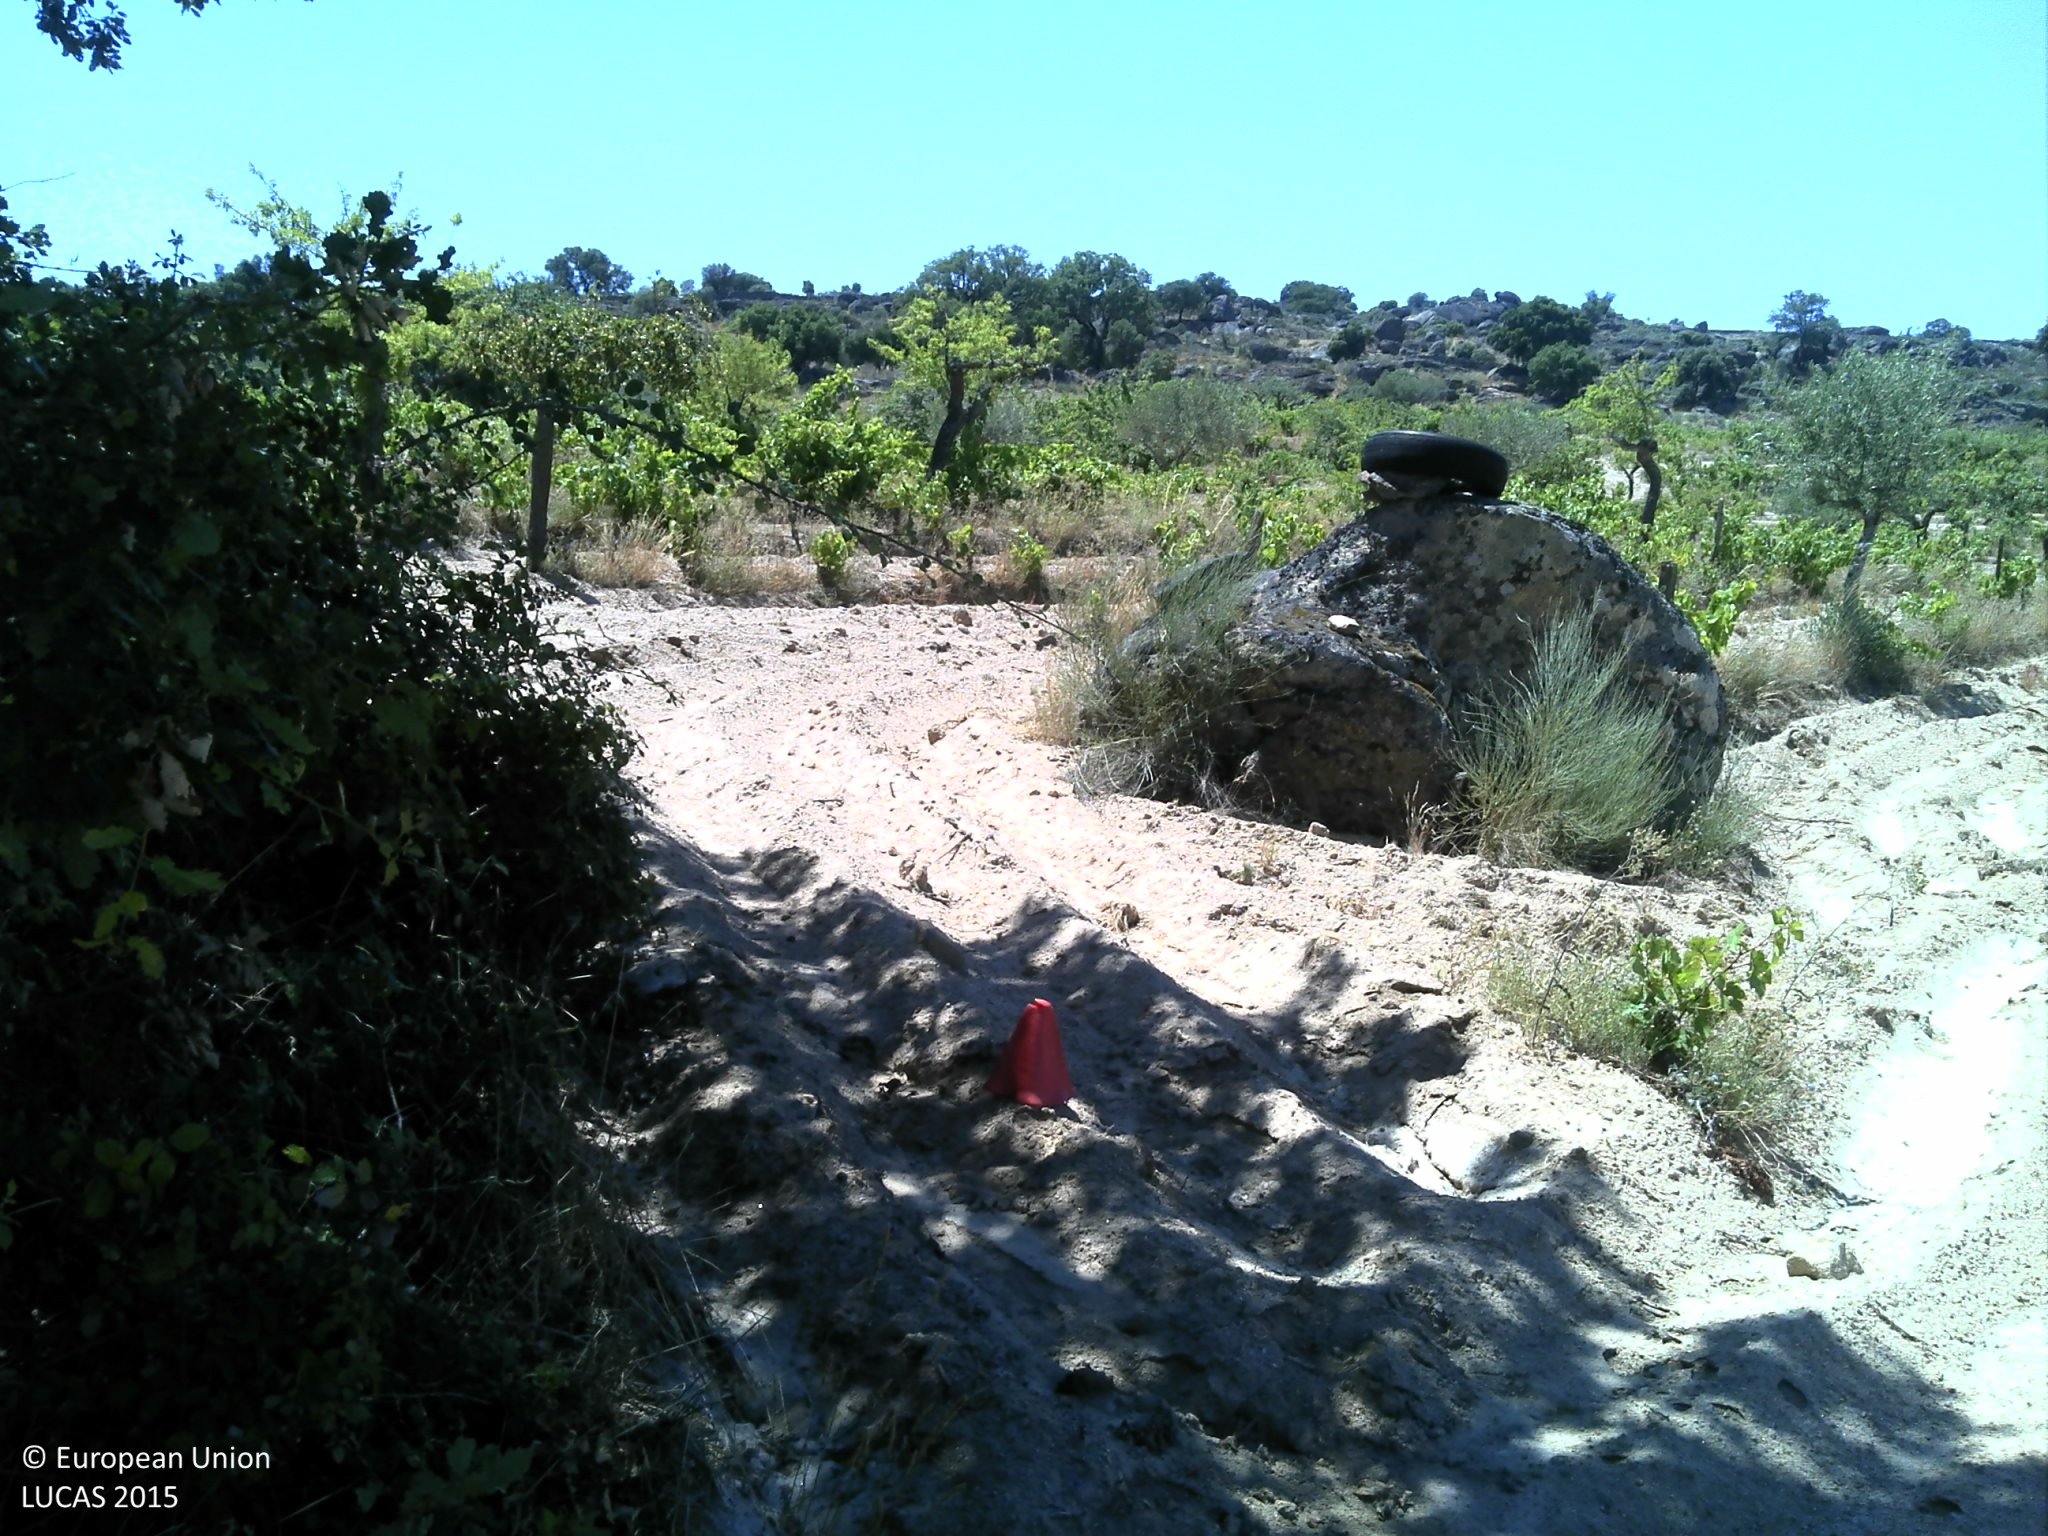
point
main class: Cropland
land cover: Vineyards
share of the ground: < 10 %
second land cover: Other bare soil
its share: > 75 %
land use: Agriculture (excluding fallow land and kitchen gardens)
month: June
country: PT
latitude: 40.9274
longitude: -7.0046
